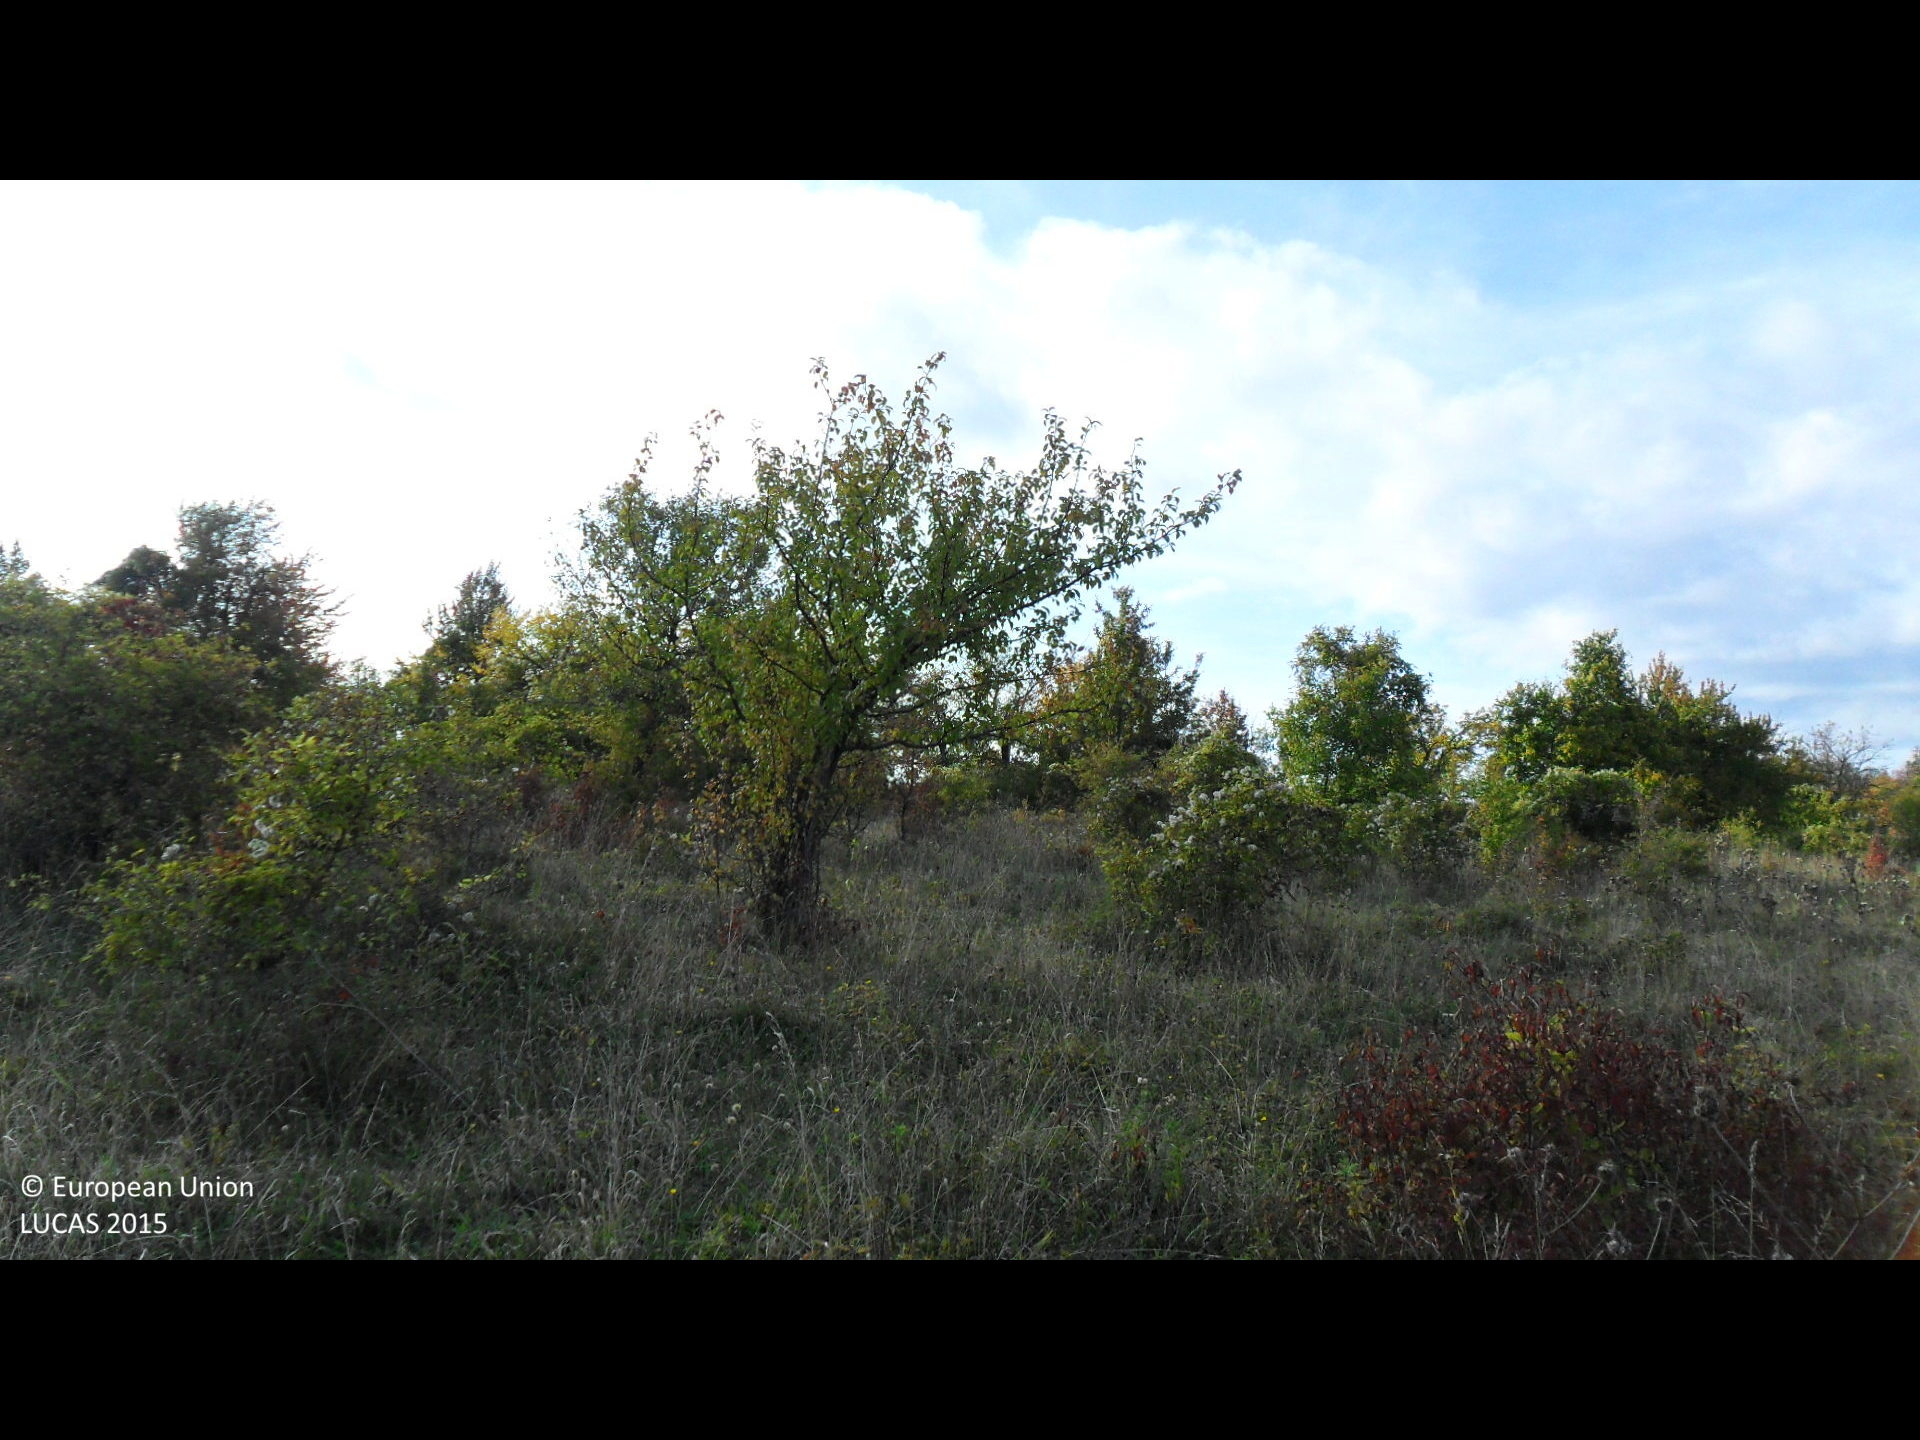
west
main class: Grassland
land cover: Grassland with sparse tree/shrub cover
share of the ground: > 75 %
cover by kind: herbaceous plants 90 %, broadleaved forest trees 5 %, shrubs 5 %
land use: Agriculture (excluding fallow land and kitchen gardens)
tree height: < 5 m
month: October
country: BG
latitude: 43.0725
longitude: 26.1677
